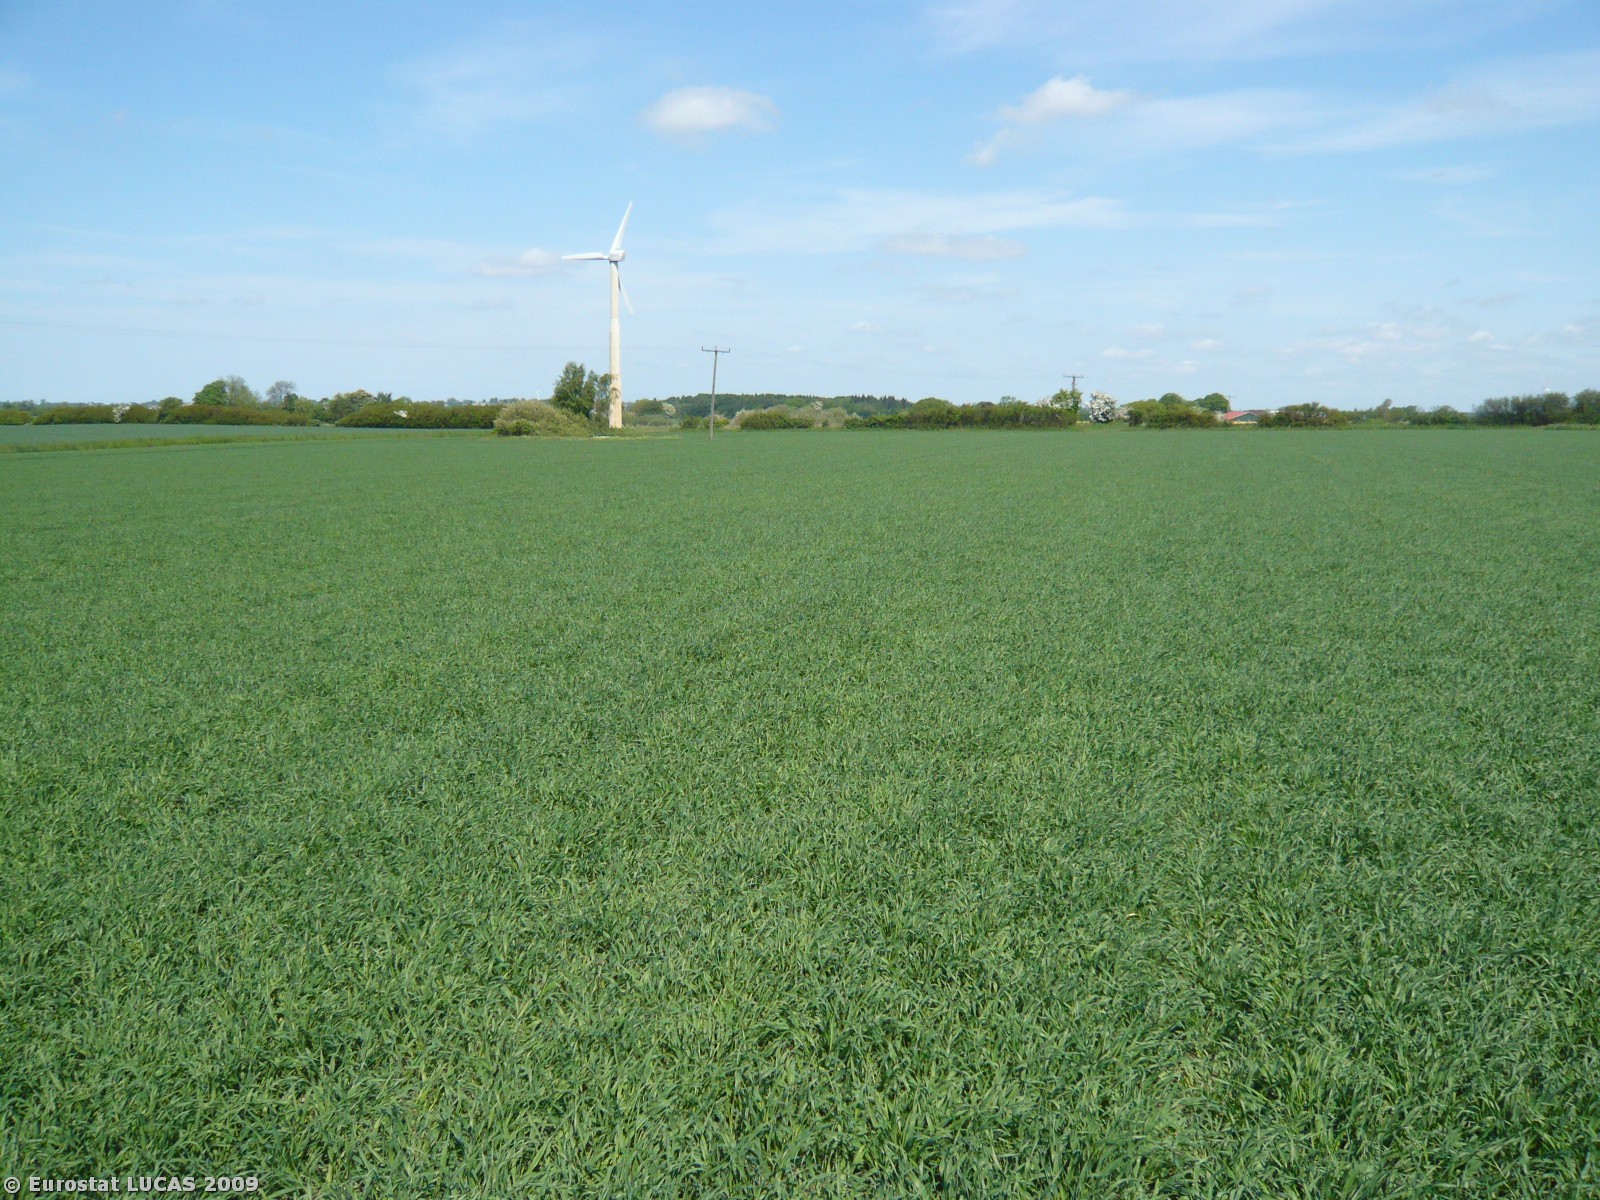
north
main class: Cropland
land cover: Barley
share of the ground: > 75 %
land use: Agriculture (excluding fallow land and kitchen gardens)
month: May
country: DK
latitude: 55.3475
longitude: 11.8436
